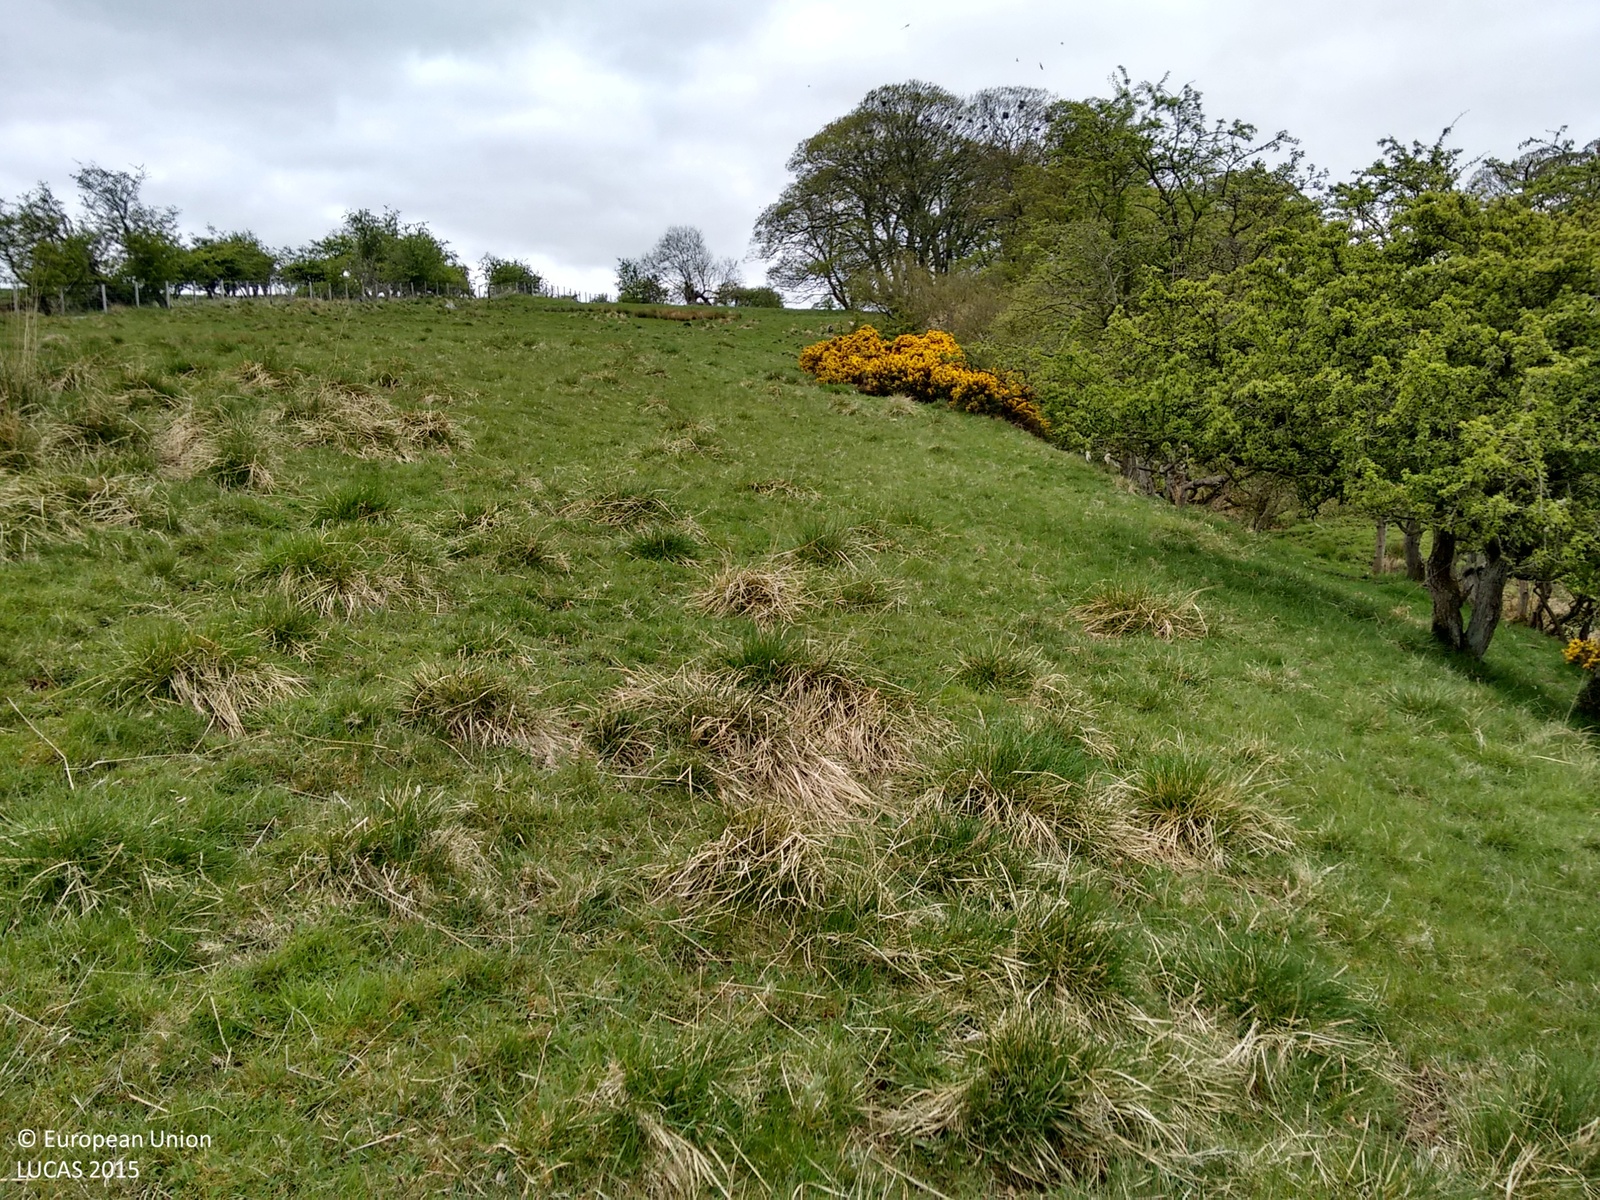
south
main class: Grassland
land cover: Grassland without tree/shrub cover
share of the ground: > 75 %
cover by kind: herbaceous plants 100 %
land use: Agriculture (excluding fallow land and kitchen gardens)
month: May
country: GB
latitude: 55.0315
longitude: -2.0870
